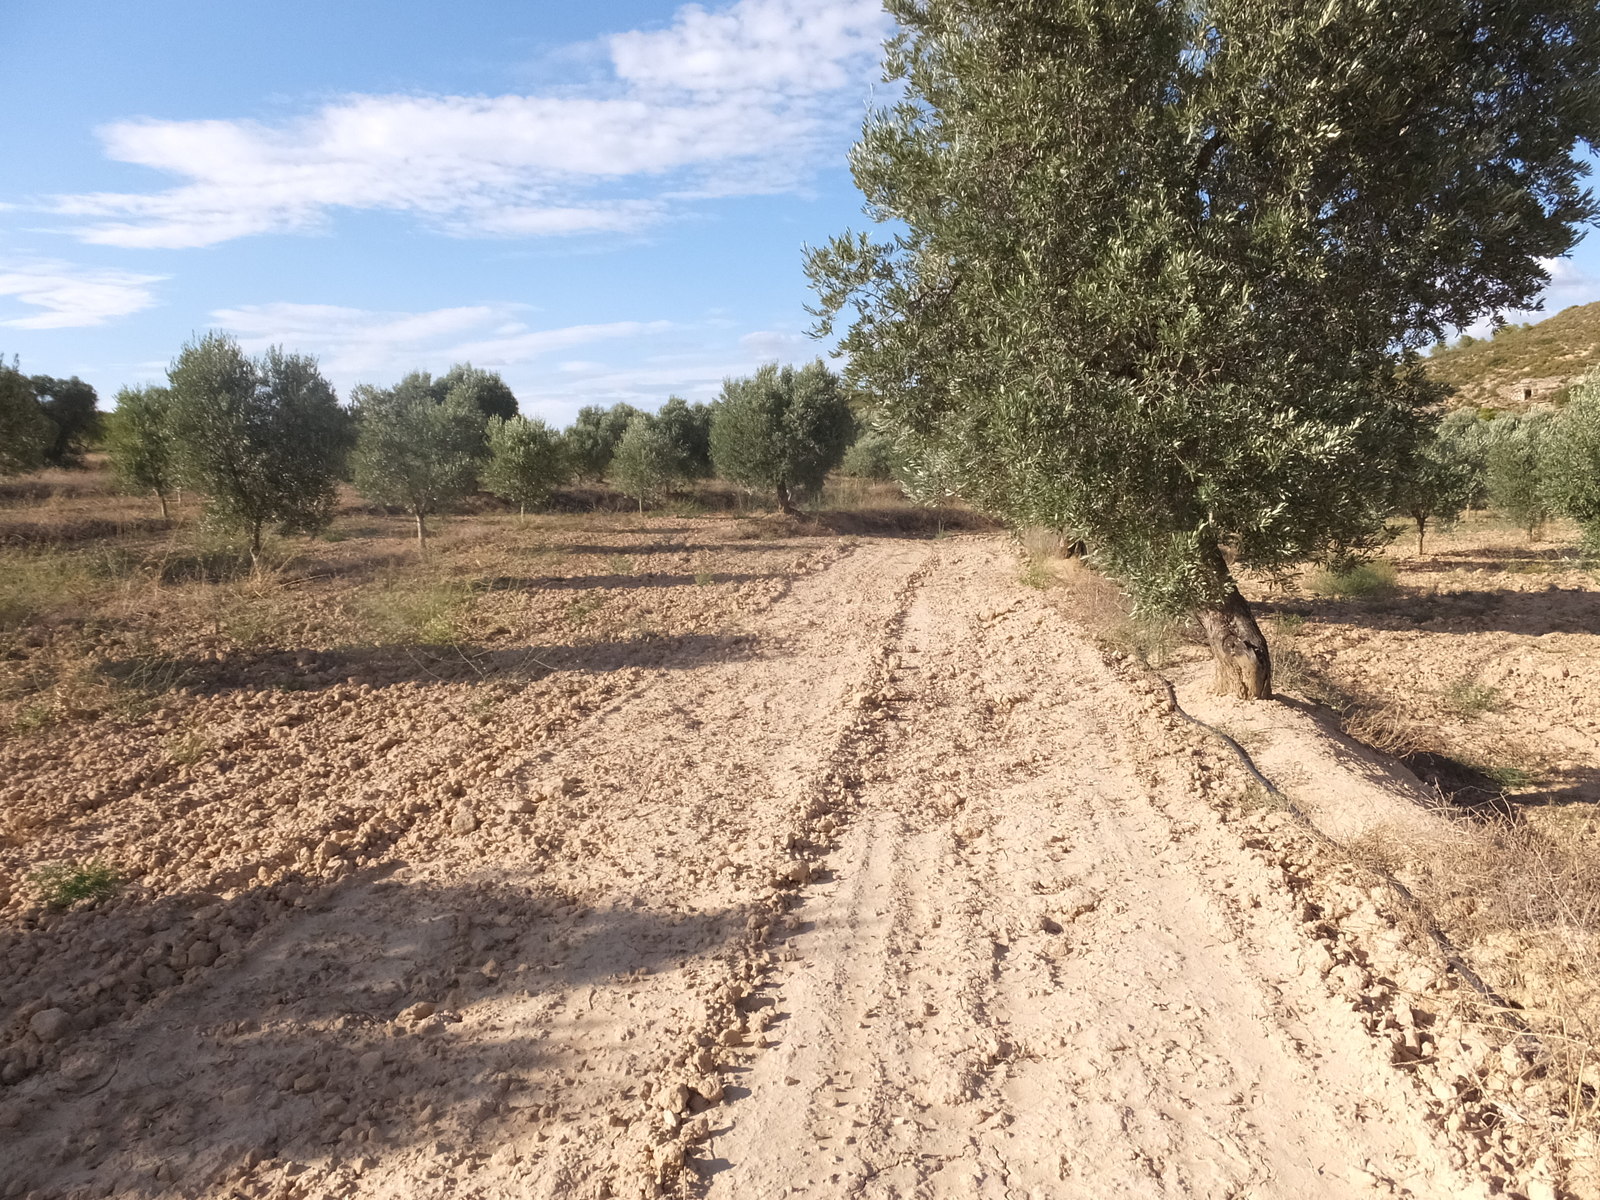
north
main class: Cropland
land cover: Olive groves
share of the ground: > 75 %
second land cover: Spontaneously vegetated surfaces
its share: < 10 %
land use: Agriculture (excluding fallow land and kitchen gardens)
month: August
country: ES
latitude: 41.2516
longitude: 0.2148
